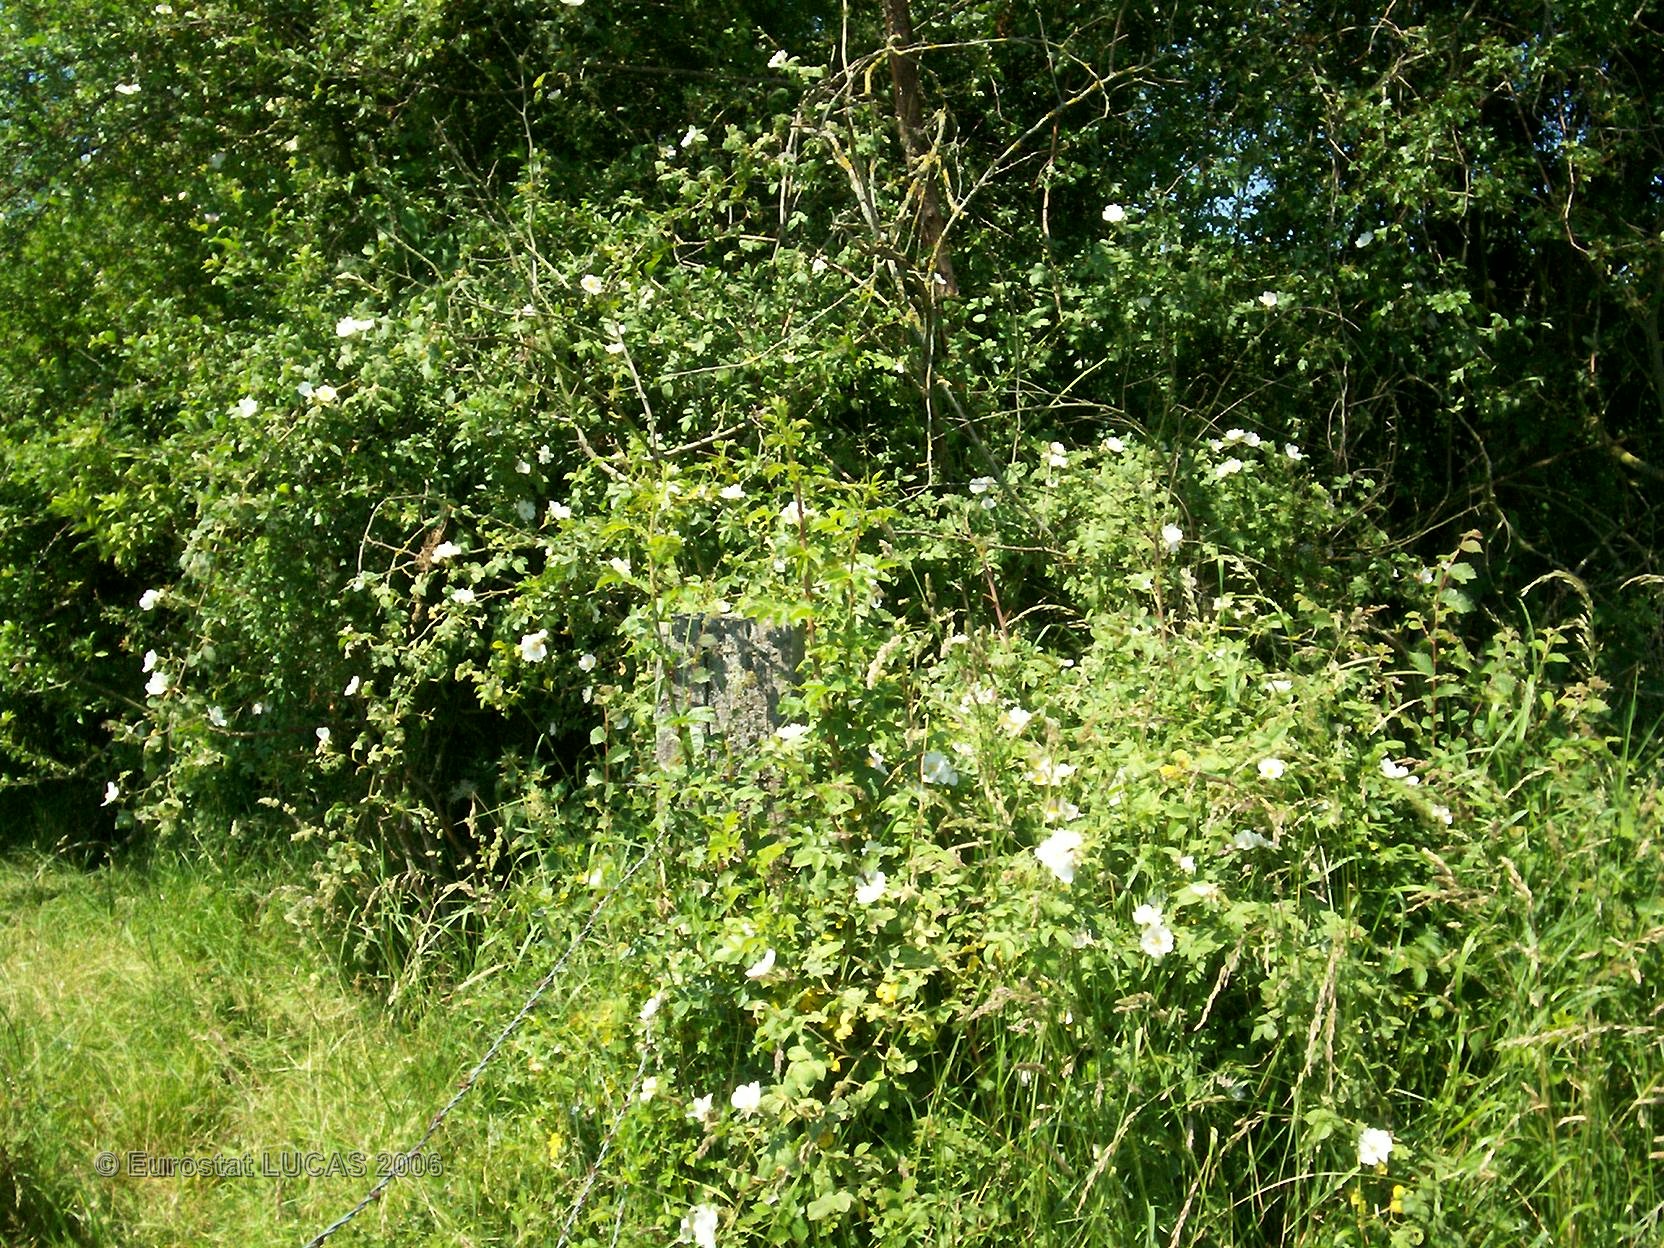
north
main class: Grassland
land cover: Grassland without tree/shrub cover
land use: Agriculture (excluding fallow land and kitchen gardens)
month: June
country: FR
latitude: 48.8583
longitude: 4.8045
